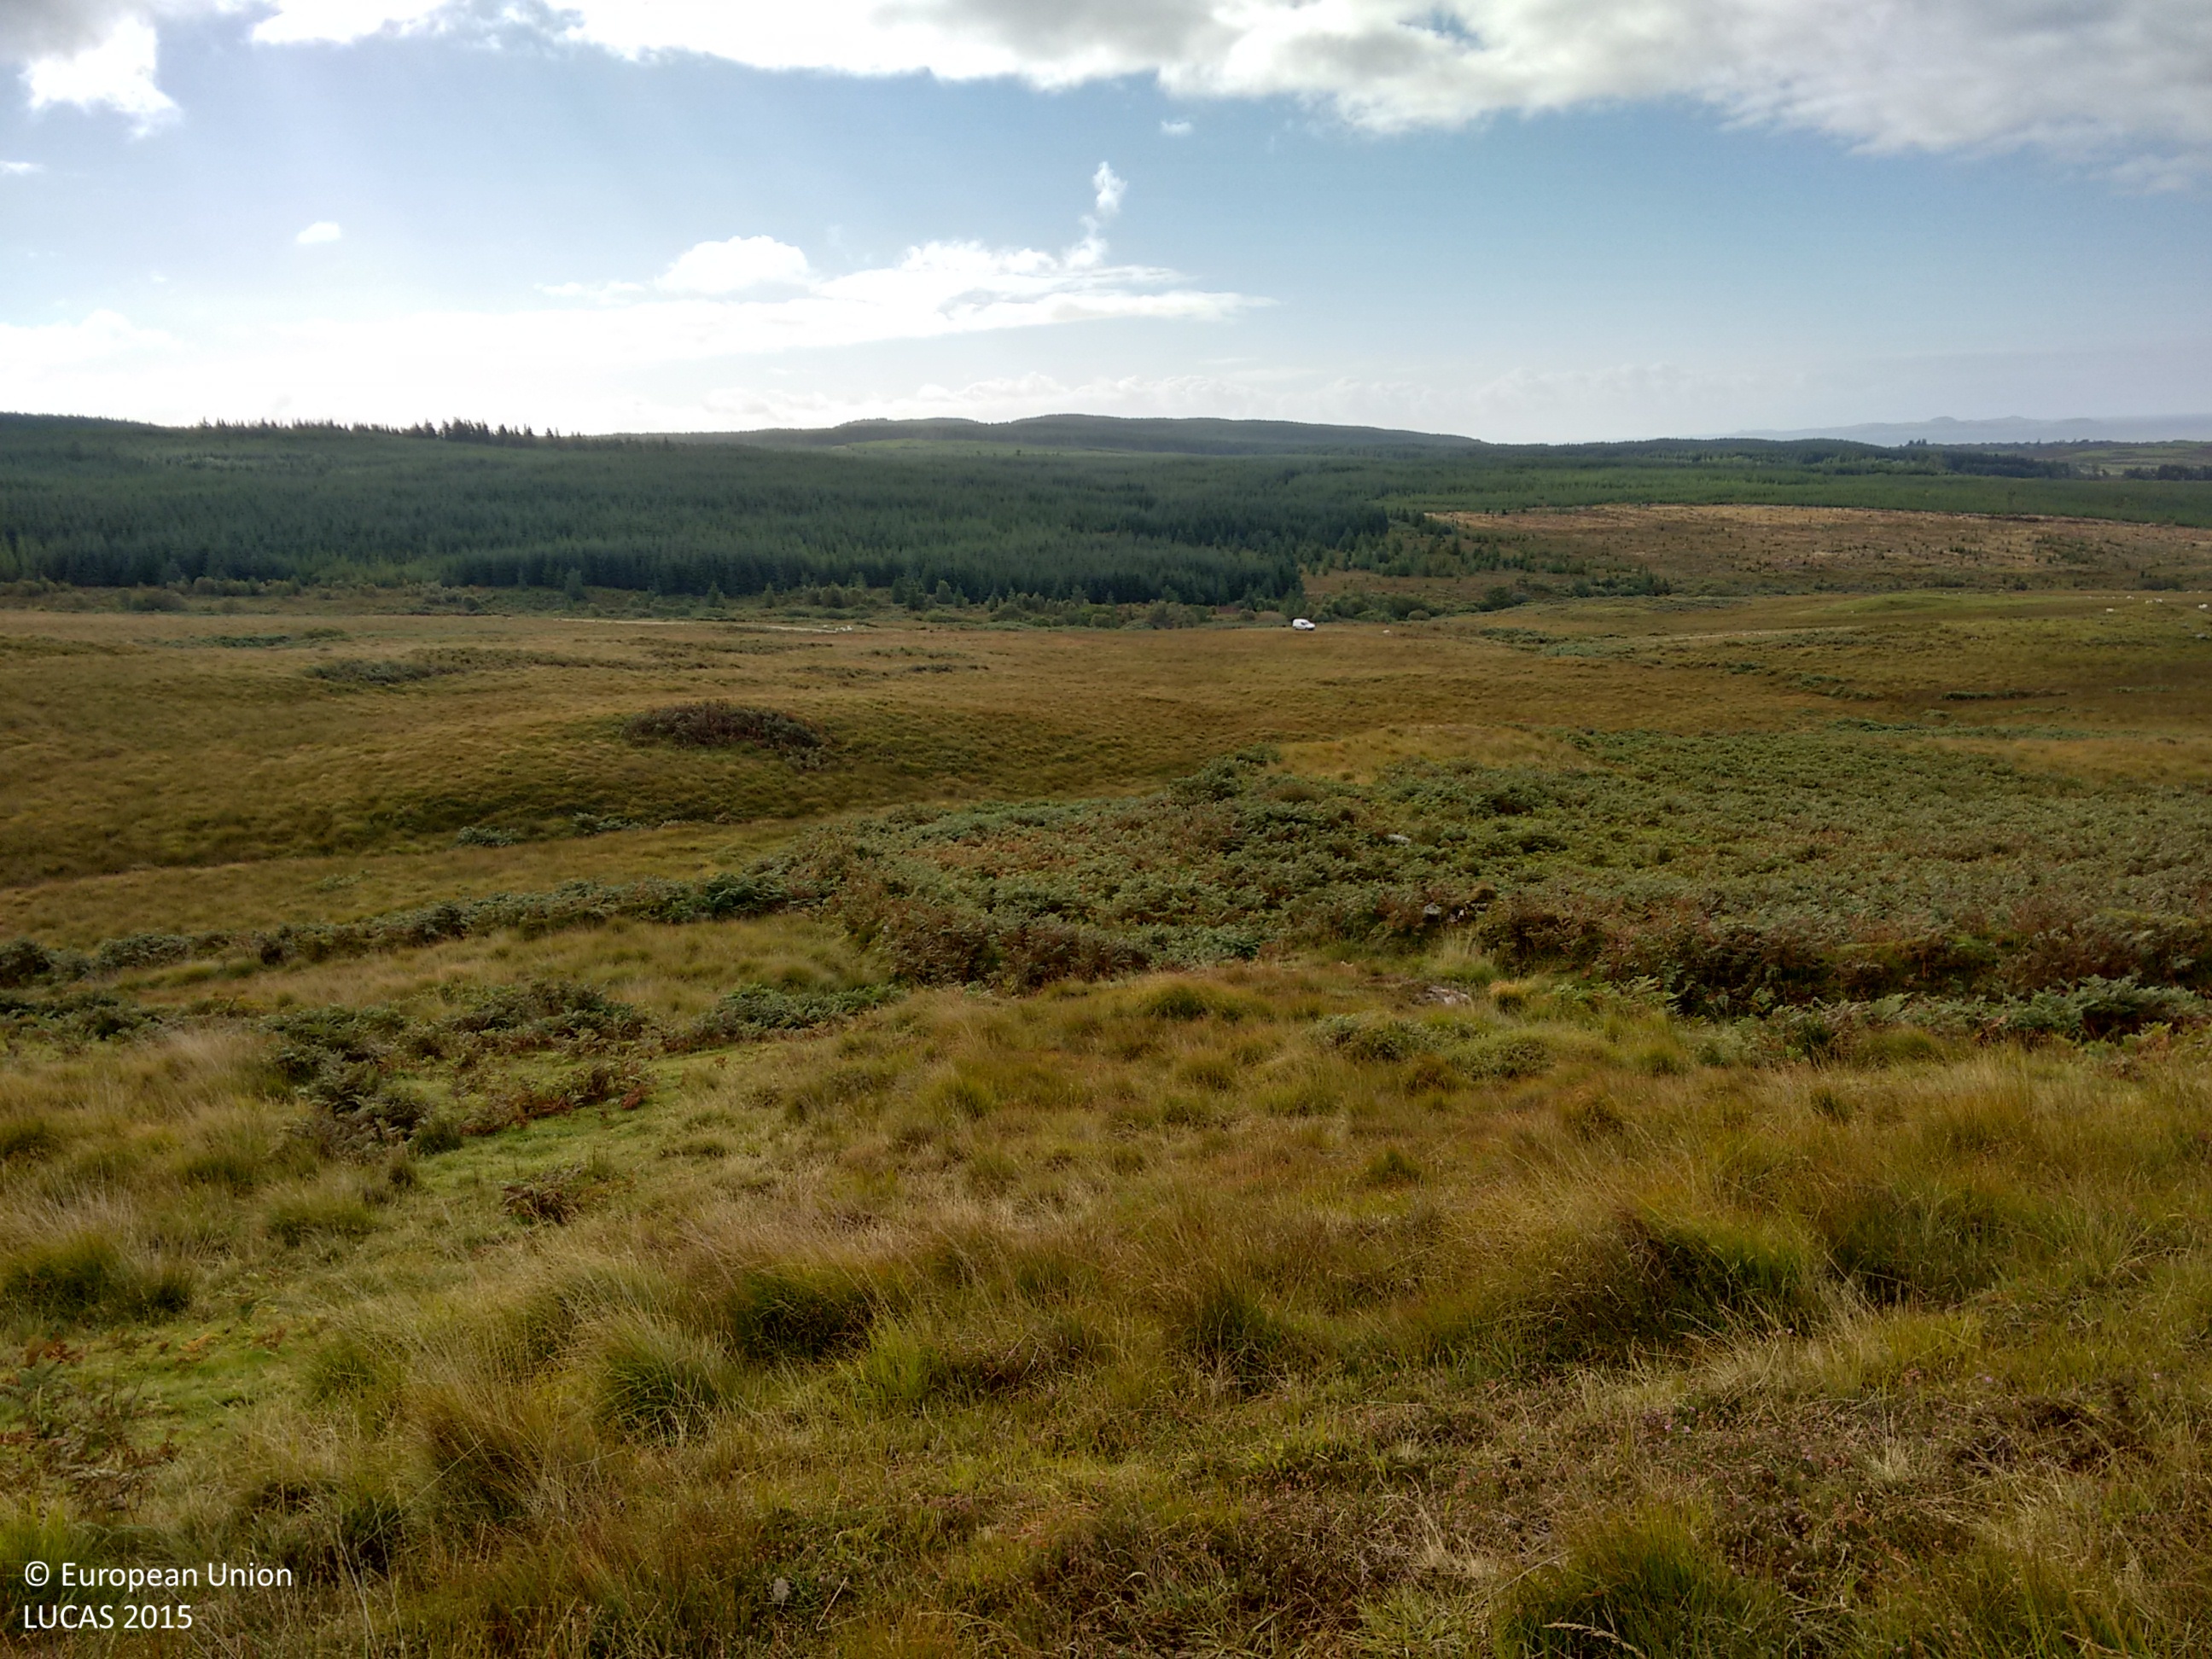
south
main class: Shrubland
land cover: Shrubland without tree cover
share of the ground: > 75 %
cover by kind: herbaceous plants 60 %, shrubs 40 %
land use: Agriculture (excluding fallow land and kitchen gardens)
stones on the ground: < 10 %
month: September
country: GB
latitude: 55.8447
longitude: -5.6341
